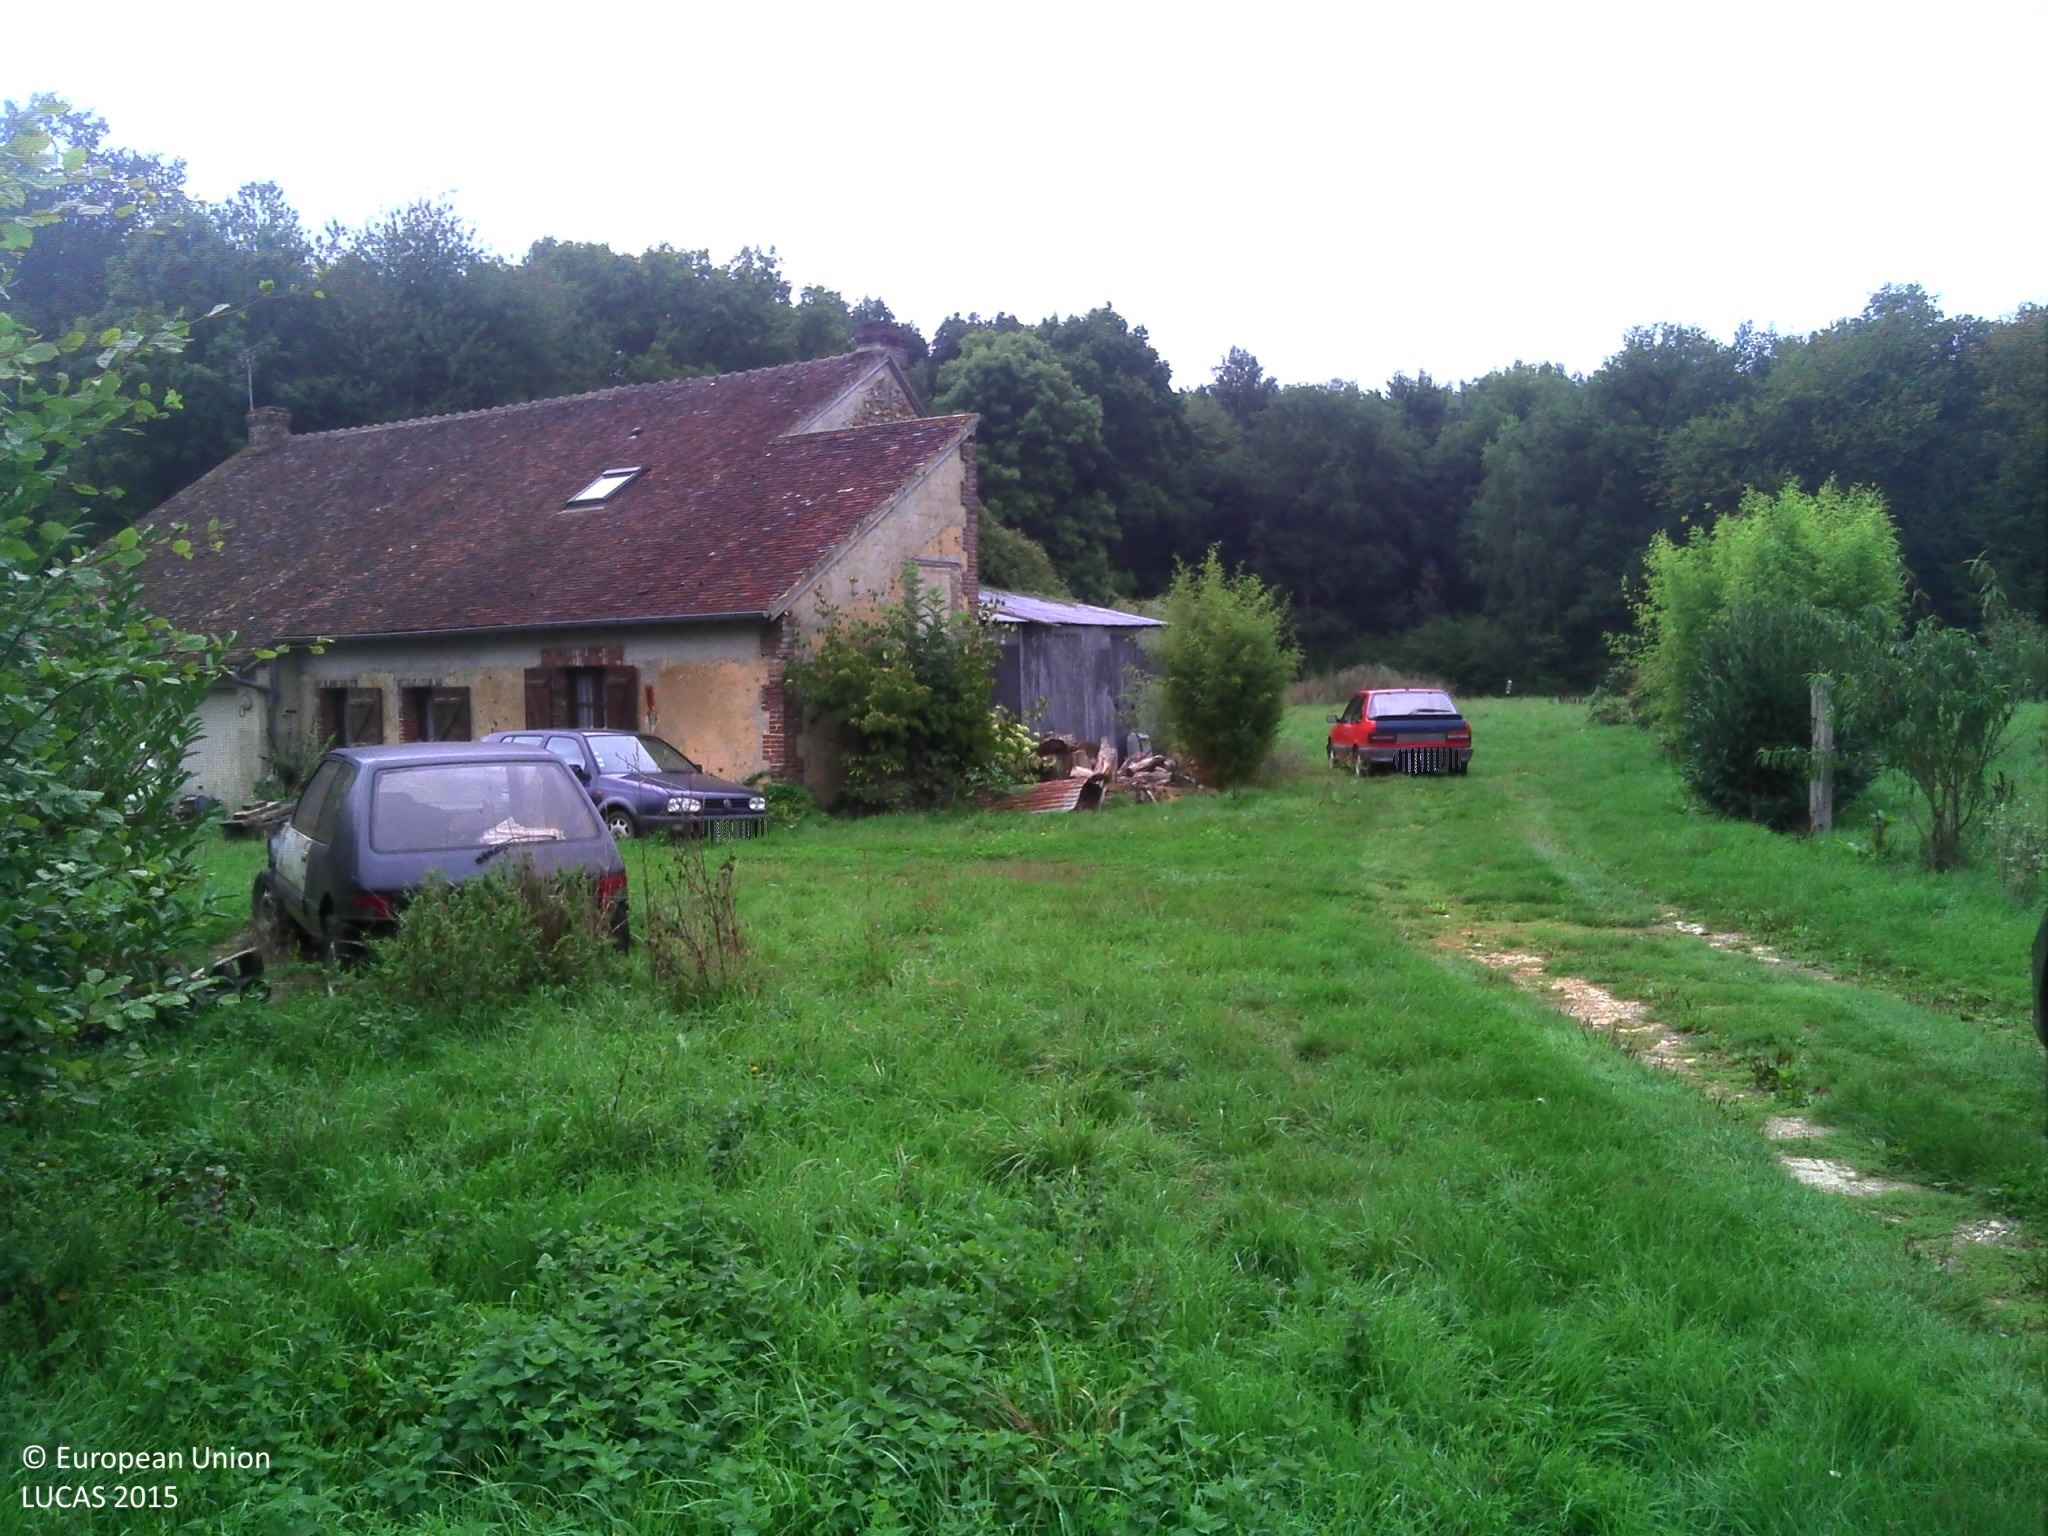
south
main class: Grassland
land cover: Grassland without tree/shrub cover
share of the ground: > 75 %
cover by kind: herbaceous plants 100 %
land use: Residential
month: September
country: FR
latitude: 48.5606
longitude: 0.7771
